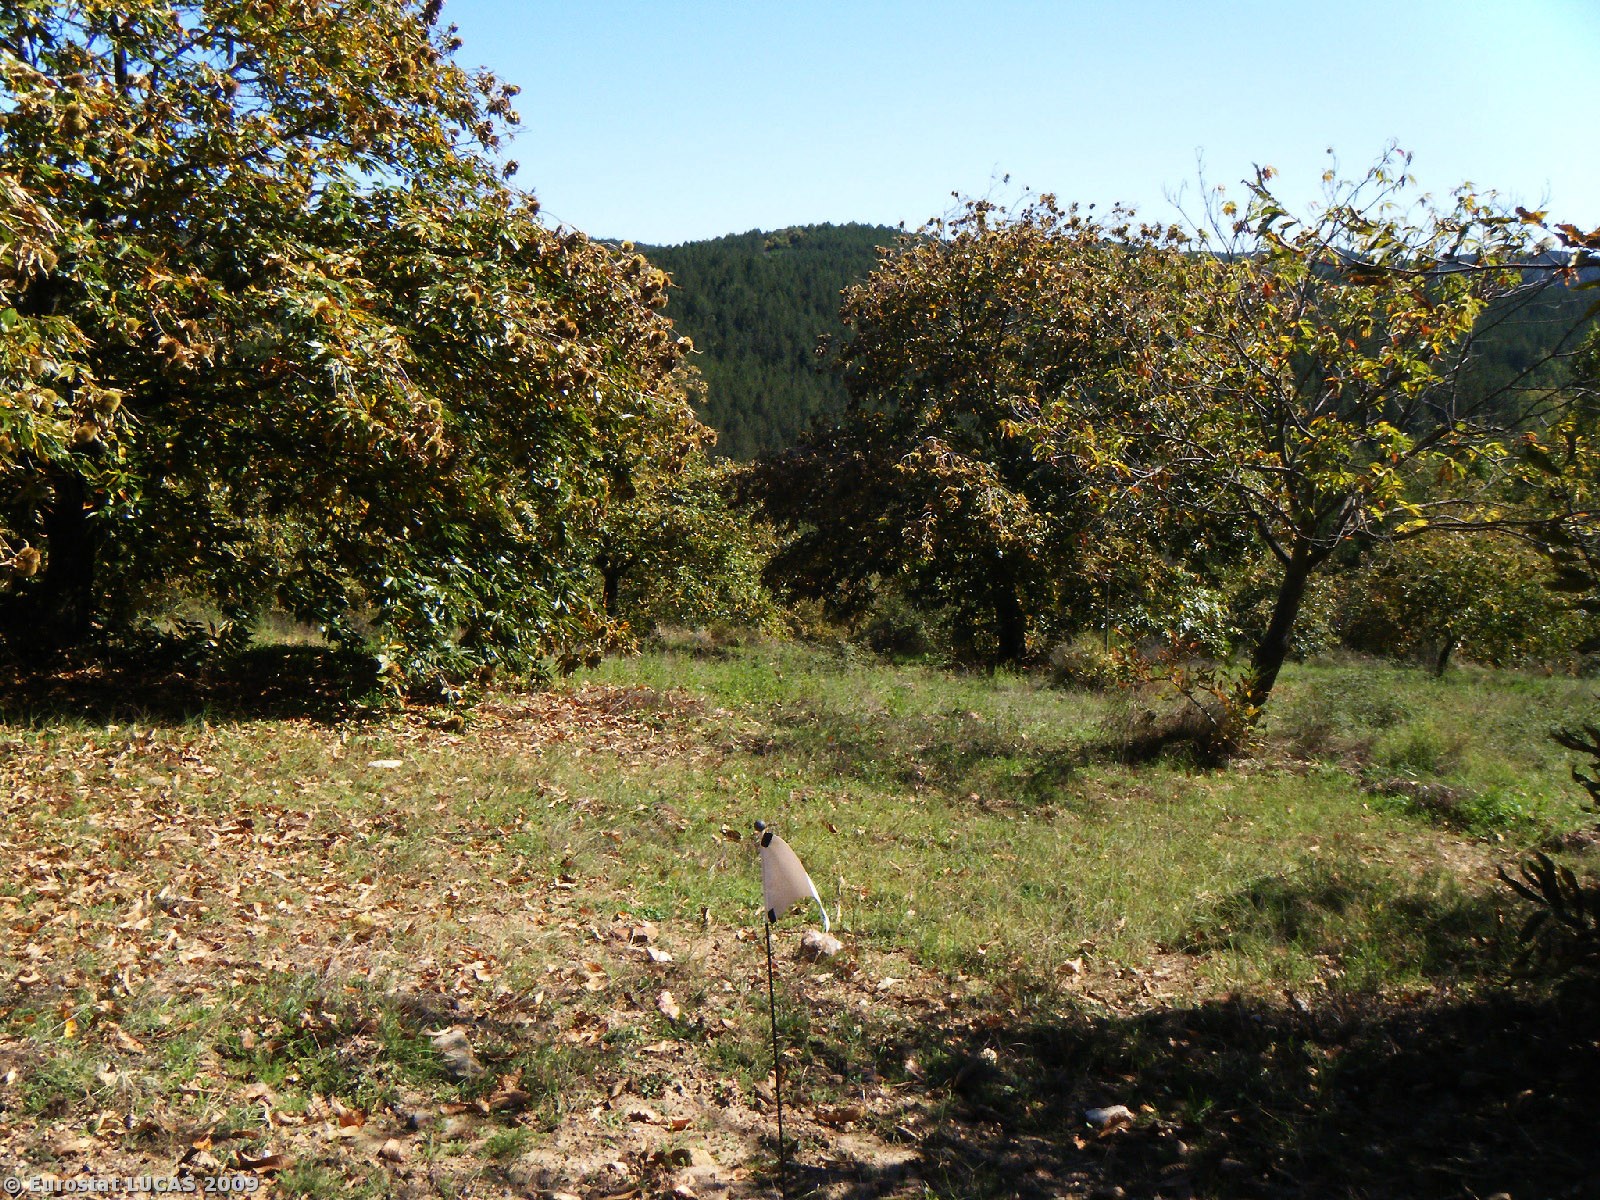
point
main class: Cropland
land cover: Nuts trees
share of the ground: 25 - 50 %
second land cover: Grassland with sparse tree/shrub cover
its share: > 75 %
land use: Agriculture (excluding fallow land and kitchen gardens)
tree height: > 5 m
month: October
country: GR
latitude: 37.3405
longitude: 22.3644
